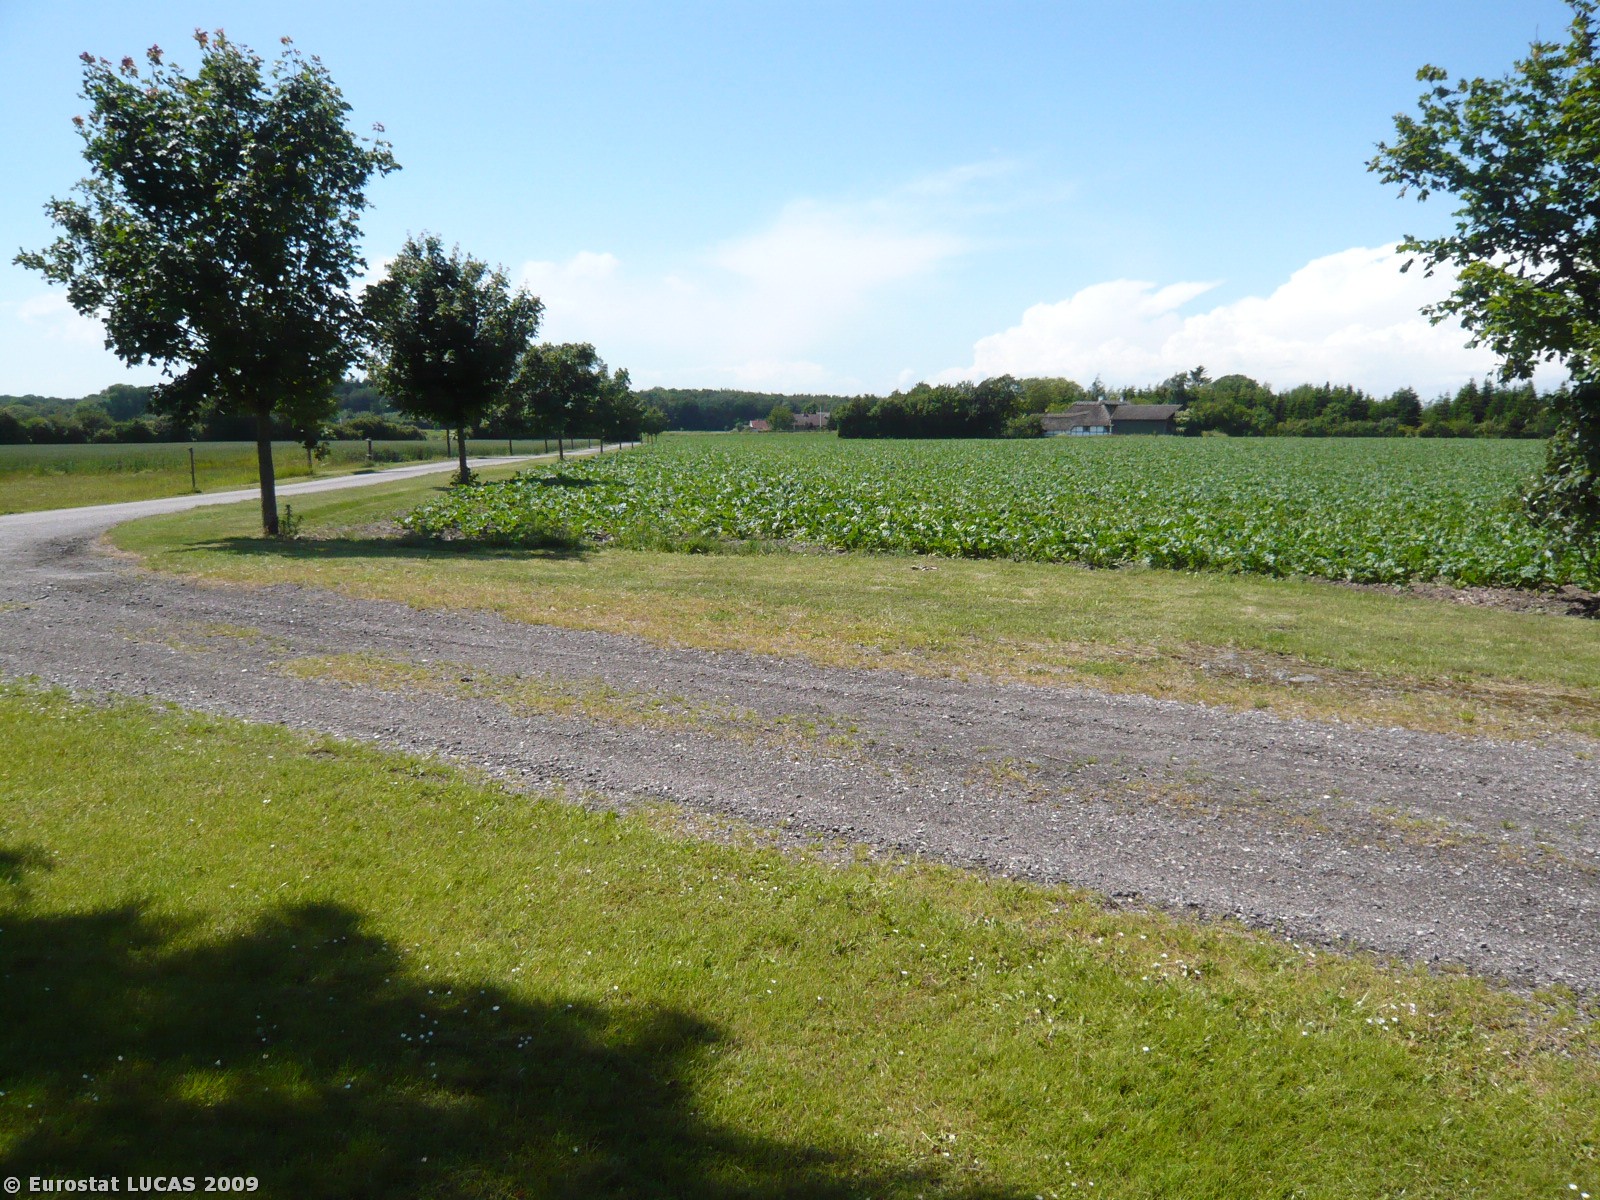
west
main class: Grassland
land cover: Grassland without tree/shrub cover
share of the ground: > 75 %
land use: Residential
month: June
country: DK
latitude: 54.7950
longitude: 11.4766
